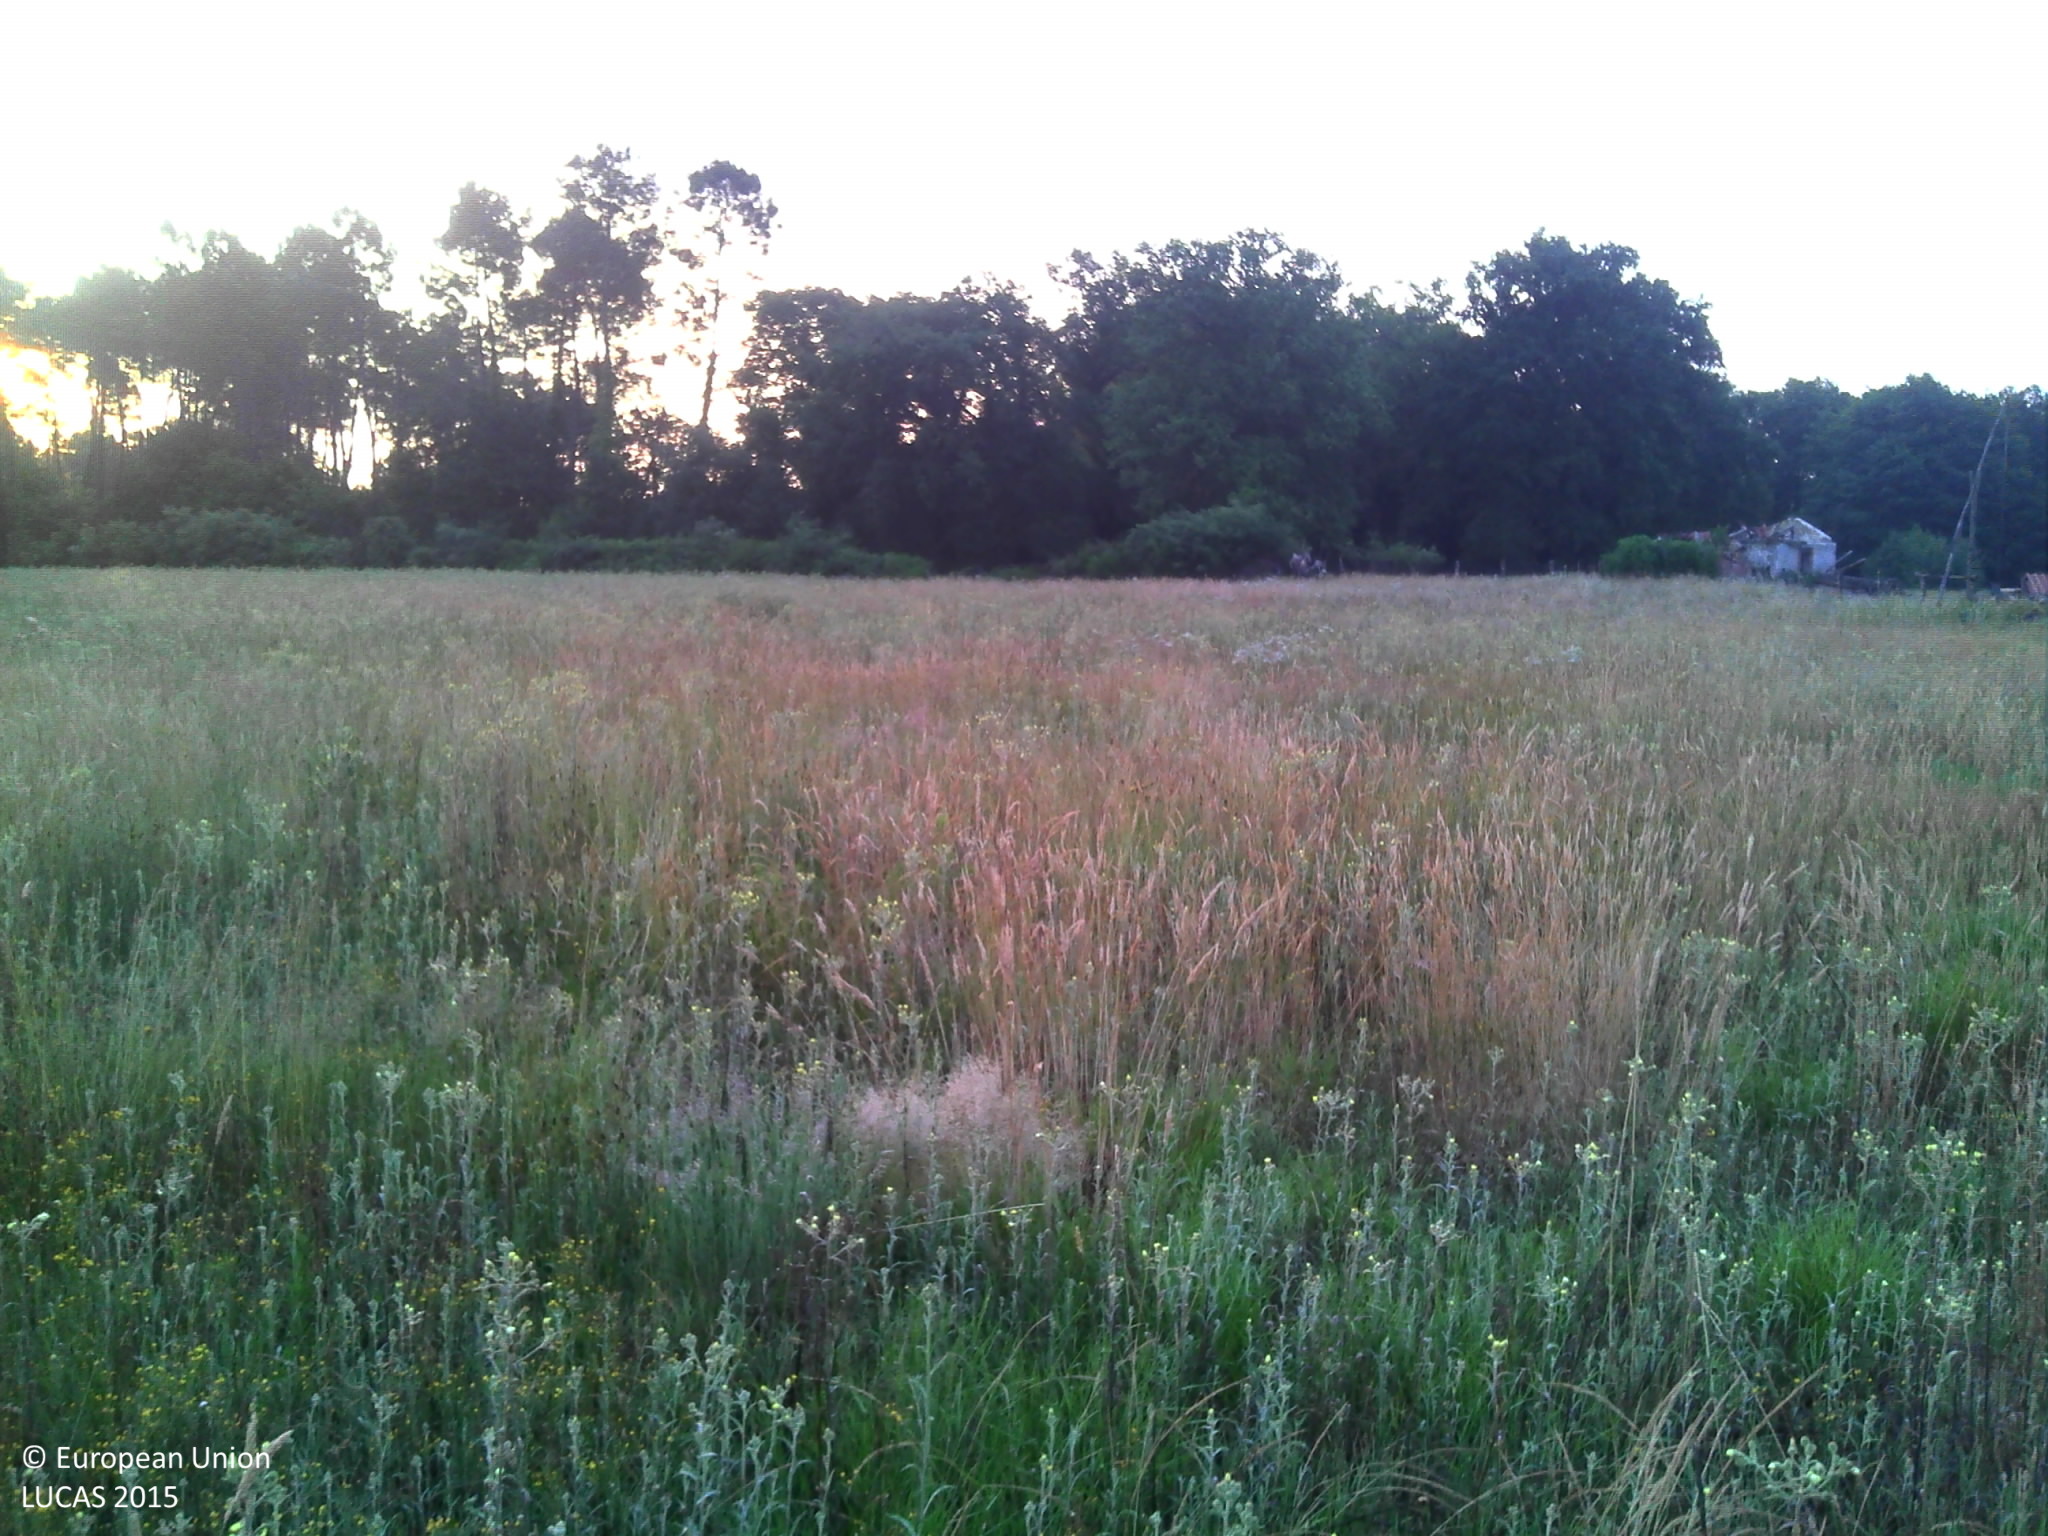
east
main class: Grassland
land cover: Spontaneously vegetated surfaces
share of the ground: > 75 %
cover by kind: herbaceous plants 95 %, shrubs 5 %
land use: Semi-natural and natural areas not in use
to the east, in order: Spontaneously vegetated surfaces; Fences; Grassland with sparse tree/shrub cover; Fences; Broadleaved woodland
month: June
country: FR
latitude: 44.0028
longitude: -0.2747
